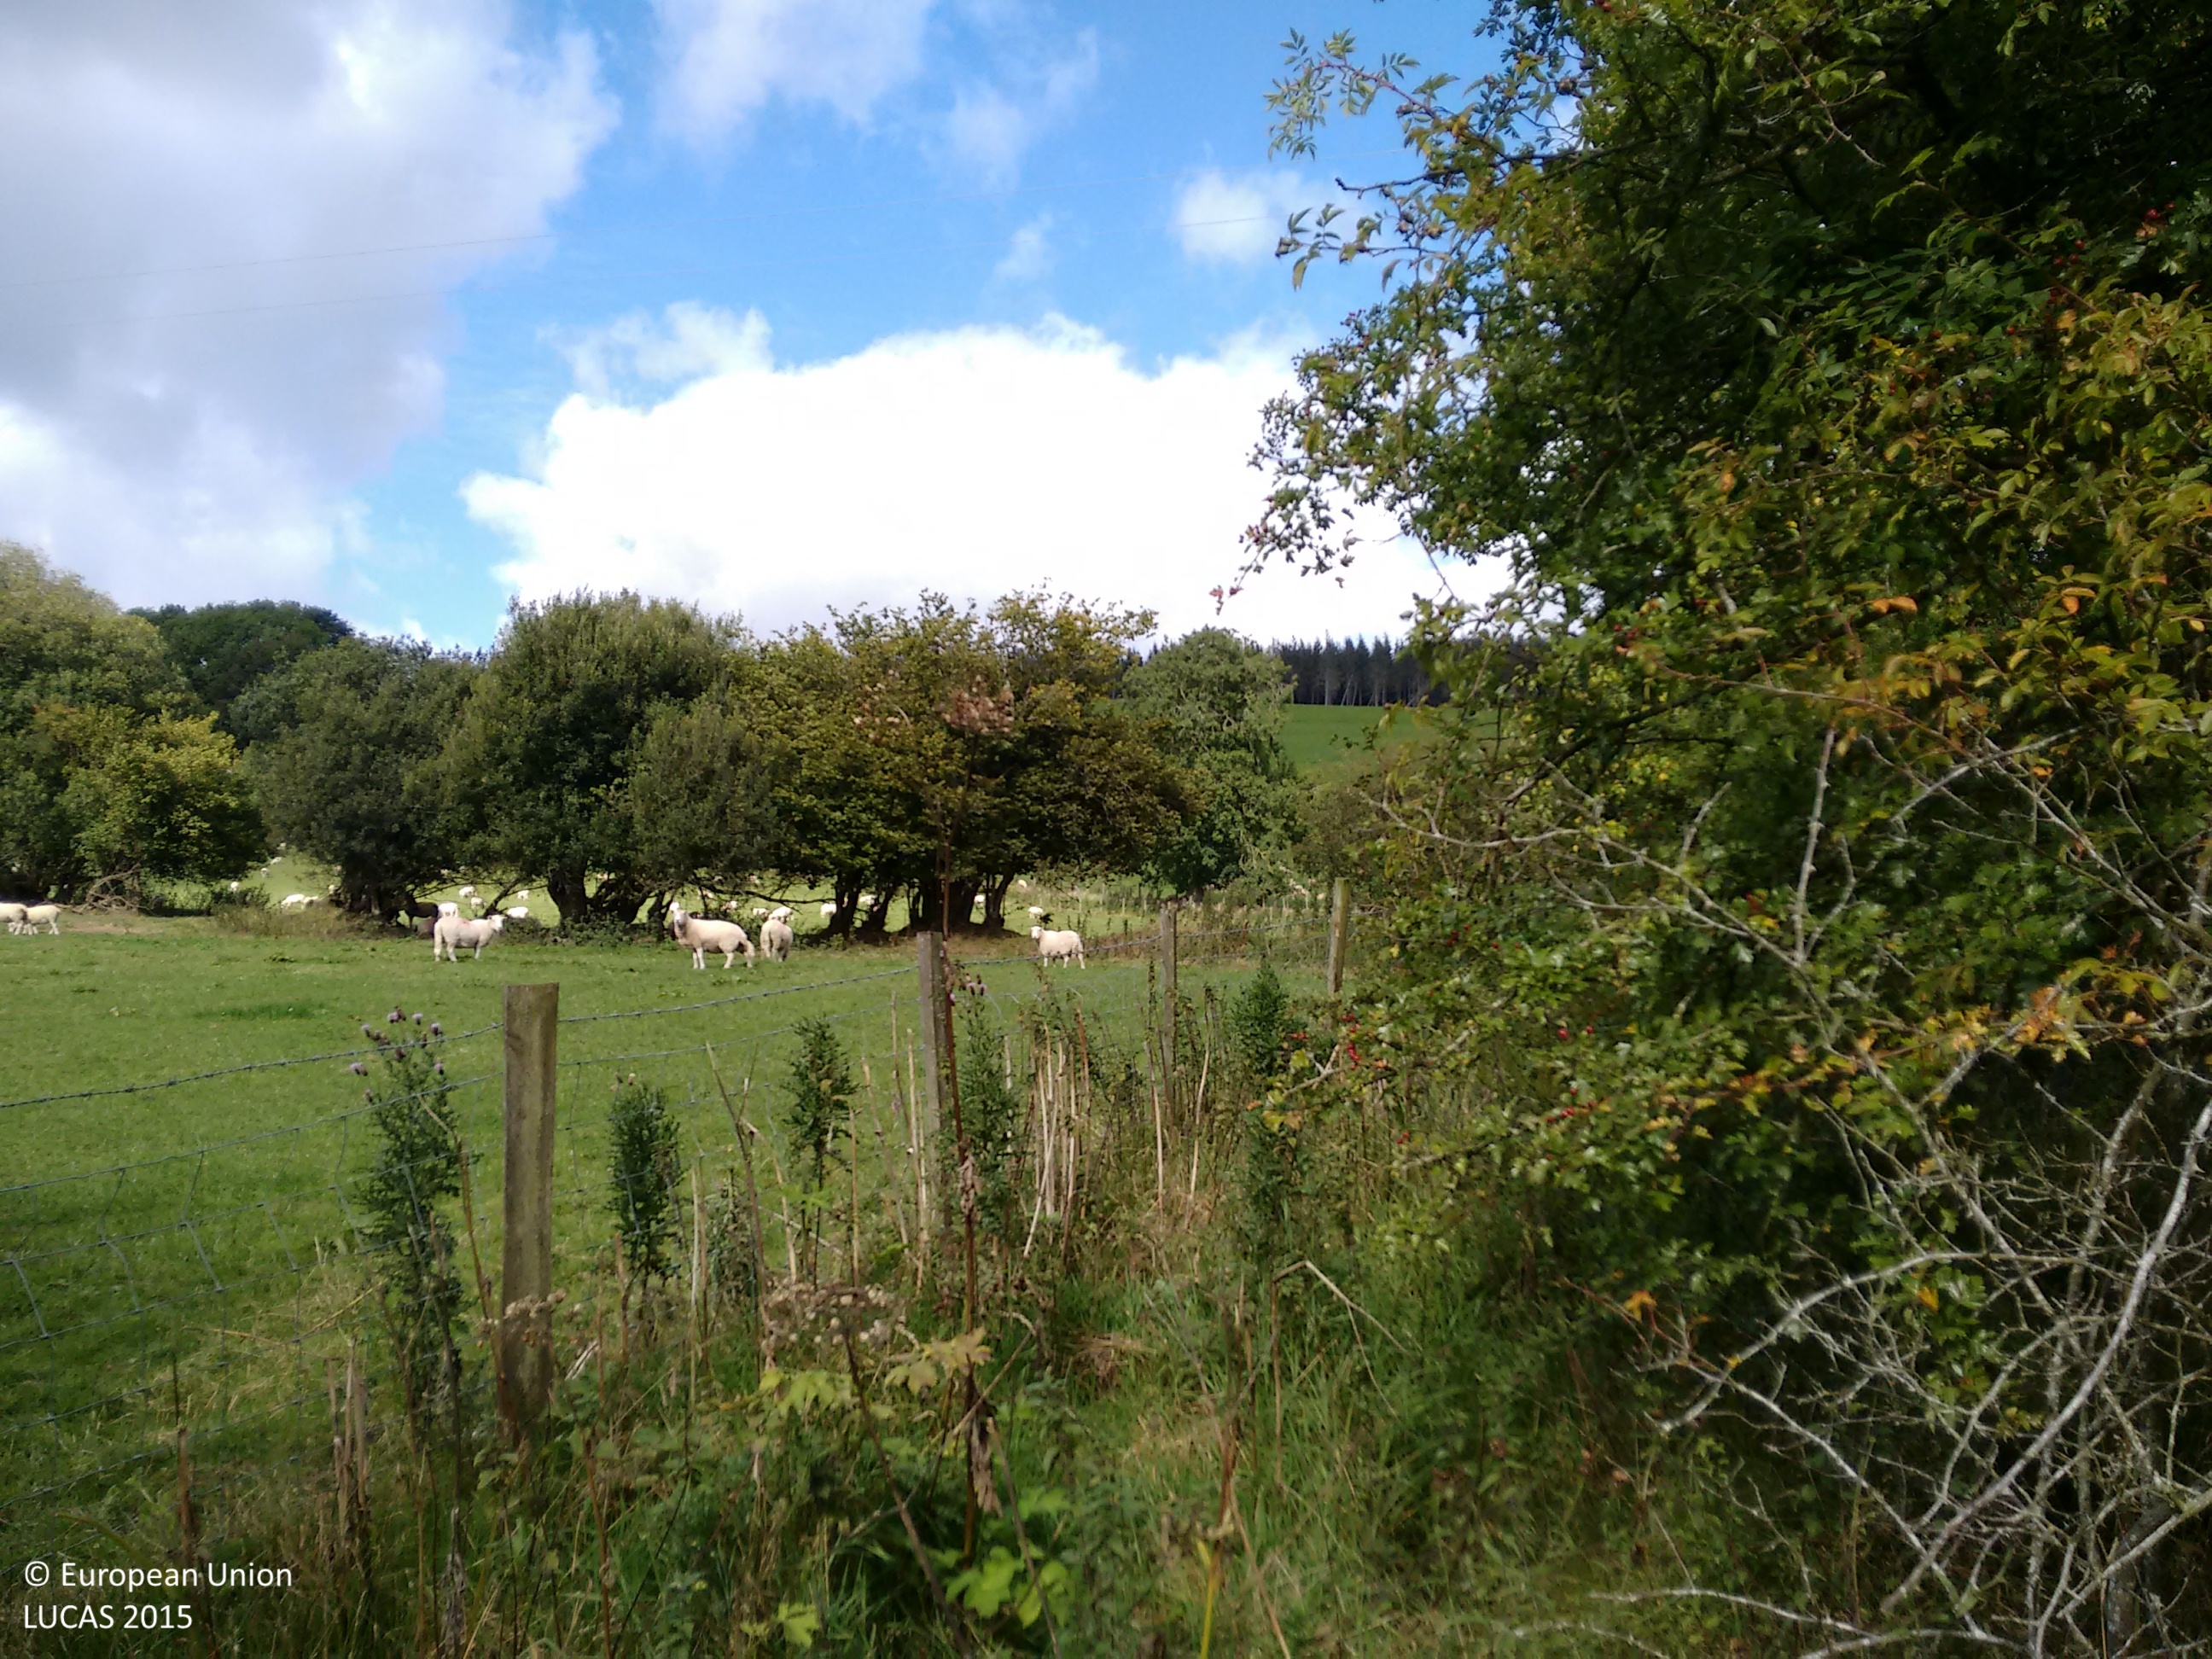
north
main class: Grassland
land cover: Grassland without tree/shrub cover
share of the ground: > 75 %
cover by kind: herbaceous plants 100 %
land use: Agriculture (excluding fallow land and kitchen gardens)
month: September
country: GB
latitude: 53.0710
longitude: -3.4104
